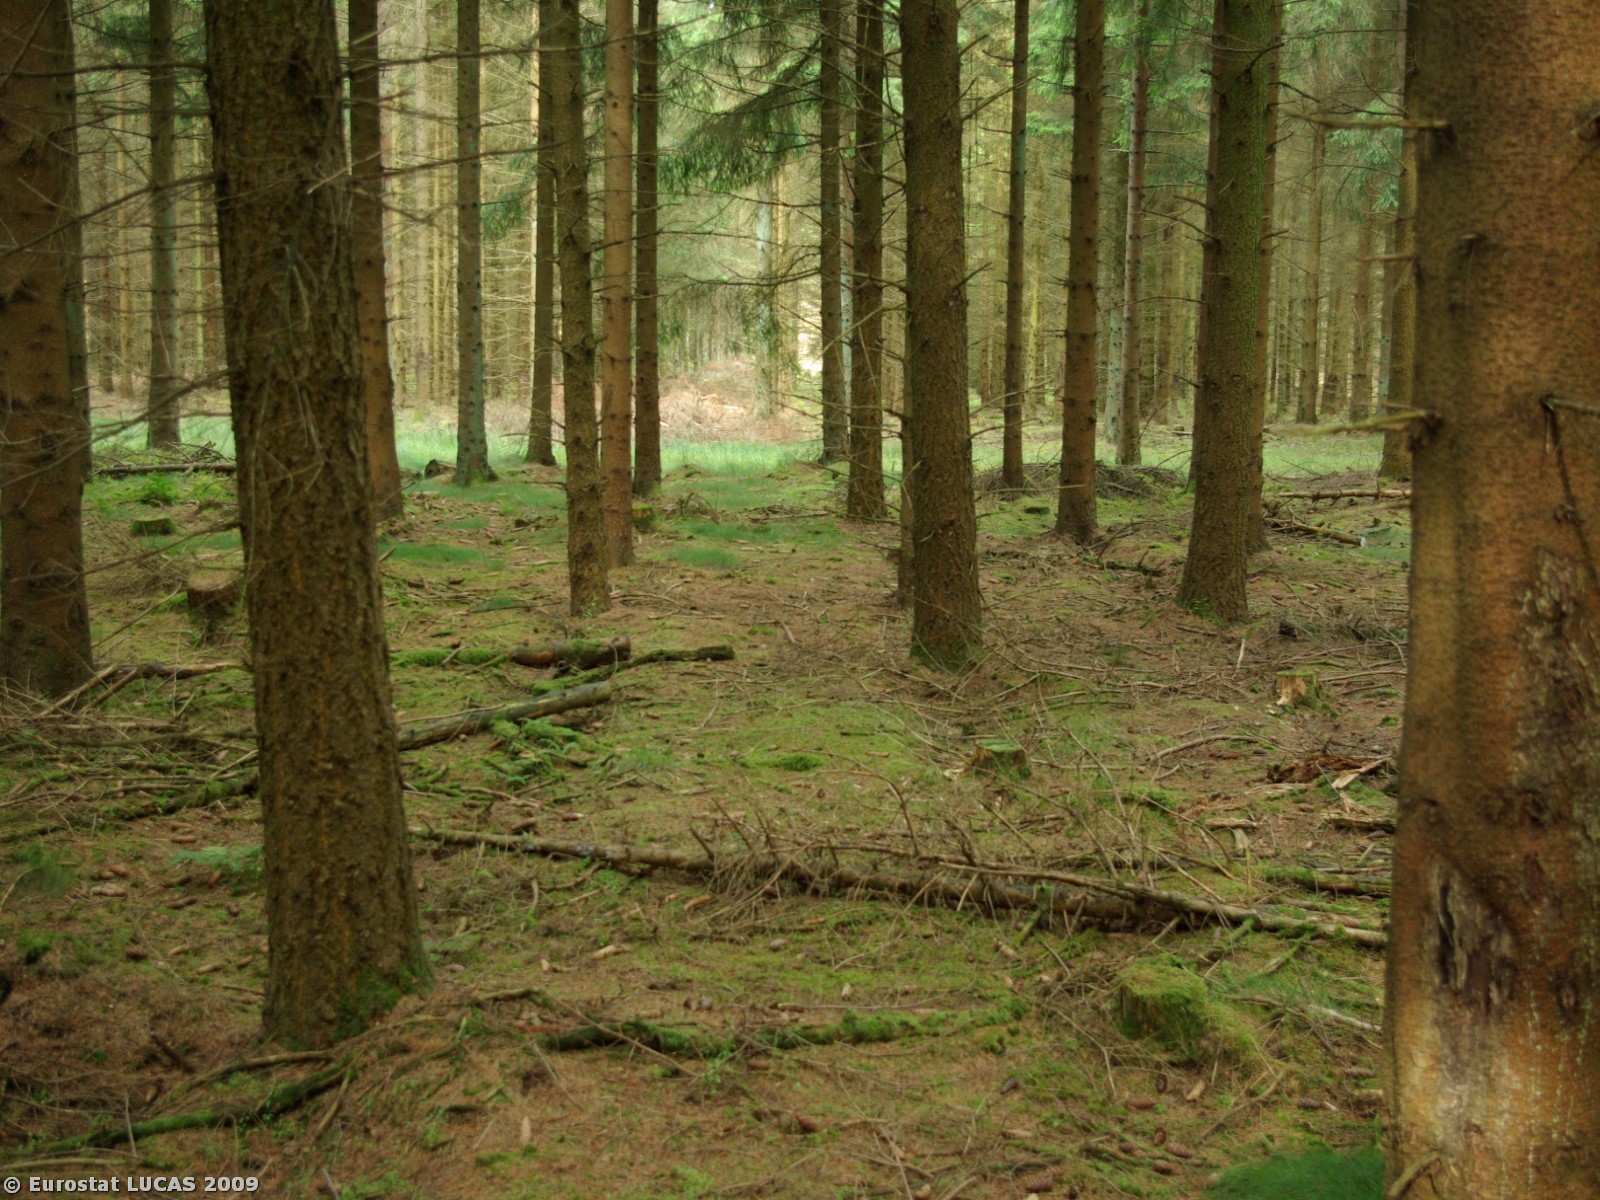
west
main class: Woodland
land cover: Coniferous woodland
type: hemiboreal forest and nemoral coniferous forest and mixed broadleaved-coniferous forest
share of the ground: > 75 %
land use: Forestry
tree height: > 5 m
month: July
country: DK
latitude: 54.8198
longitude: 9.3002
